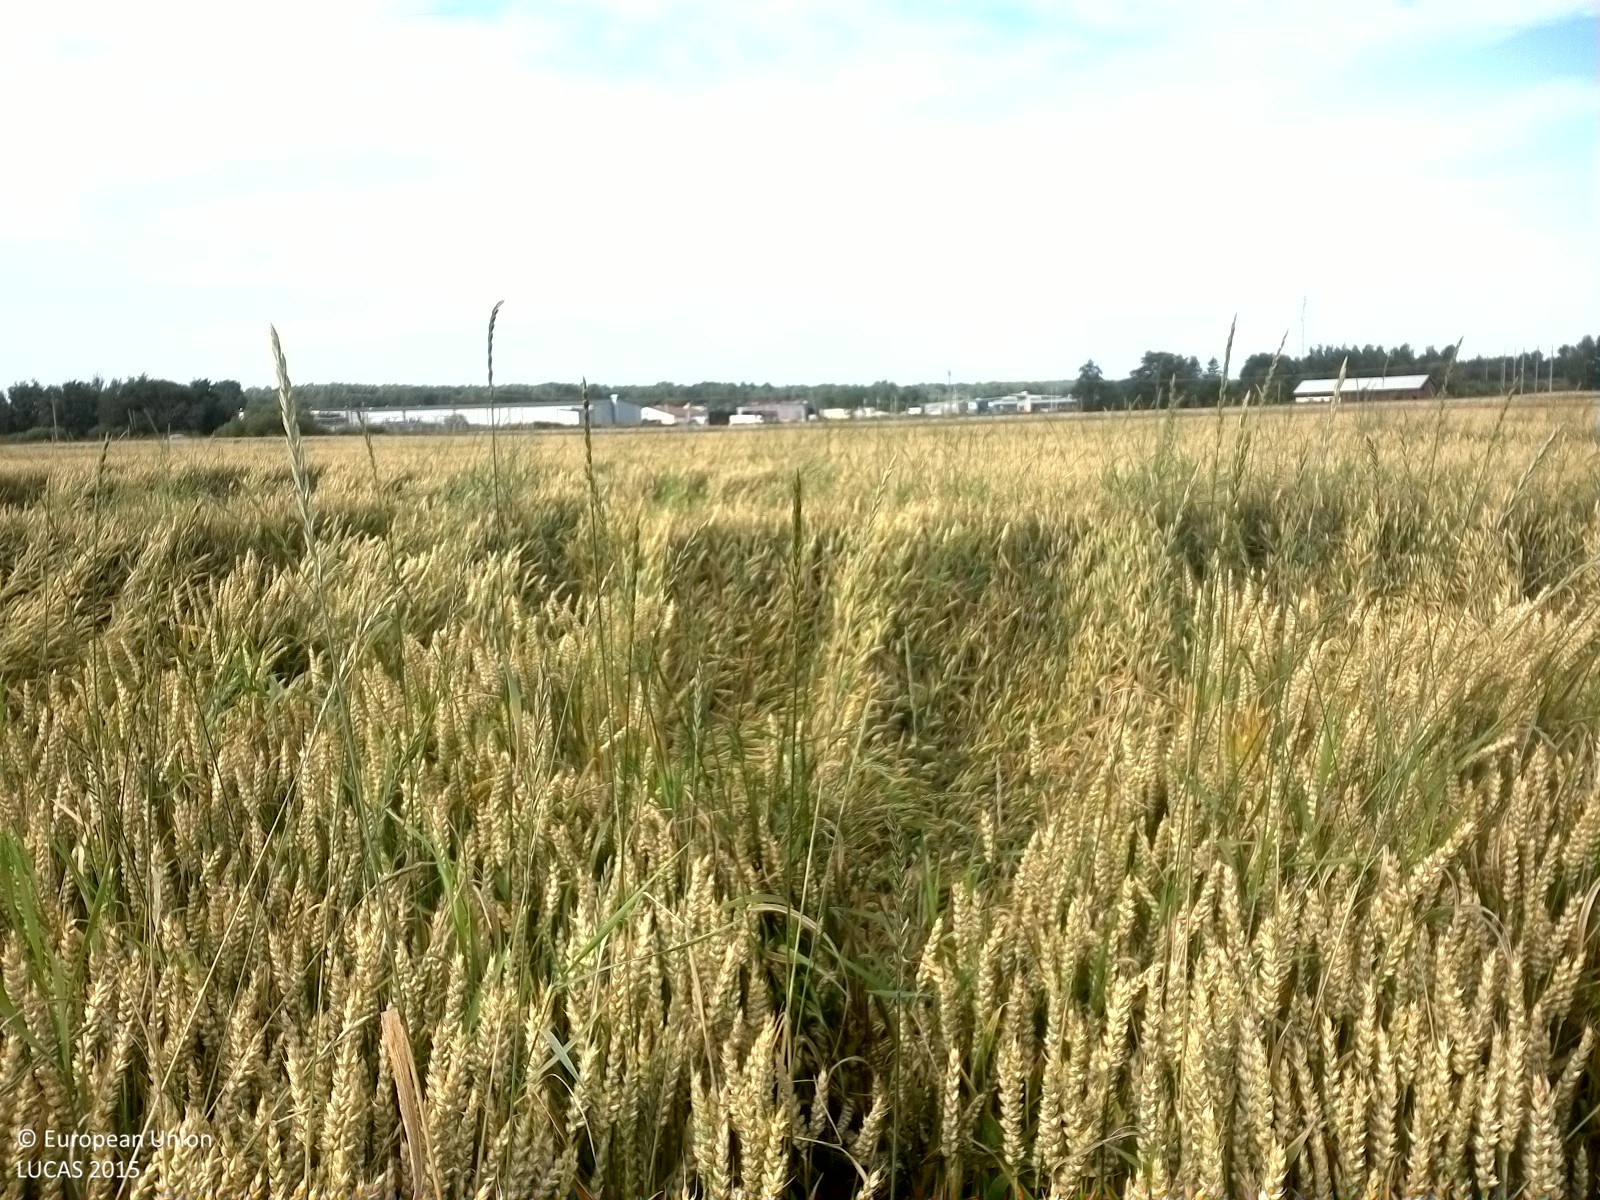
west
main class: Cropland
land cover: Common wheat
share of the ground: > 75 %
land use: Agriculture (excluding fallow land and kitchen gardens)
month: August
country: SE
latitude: 59.0782
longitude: 15.1041
